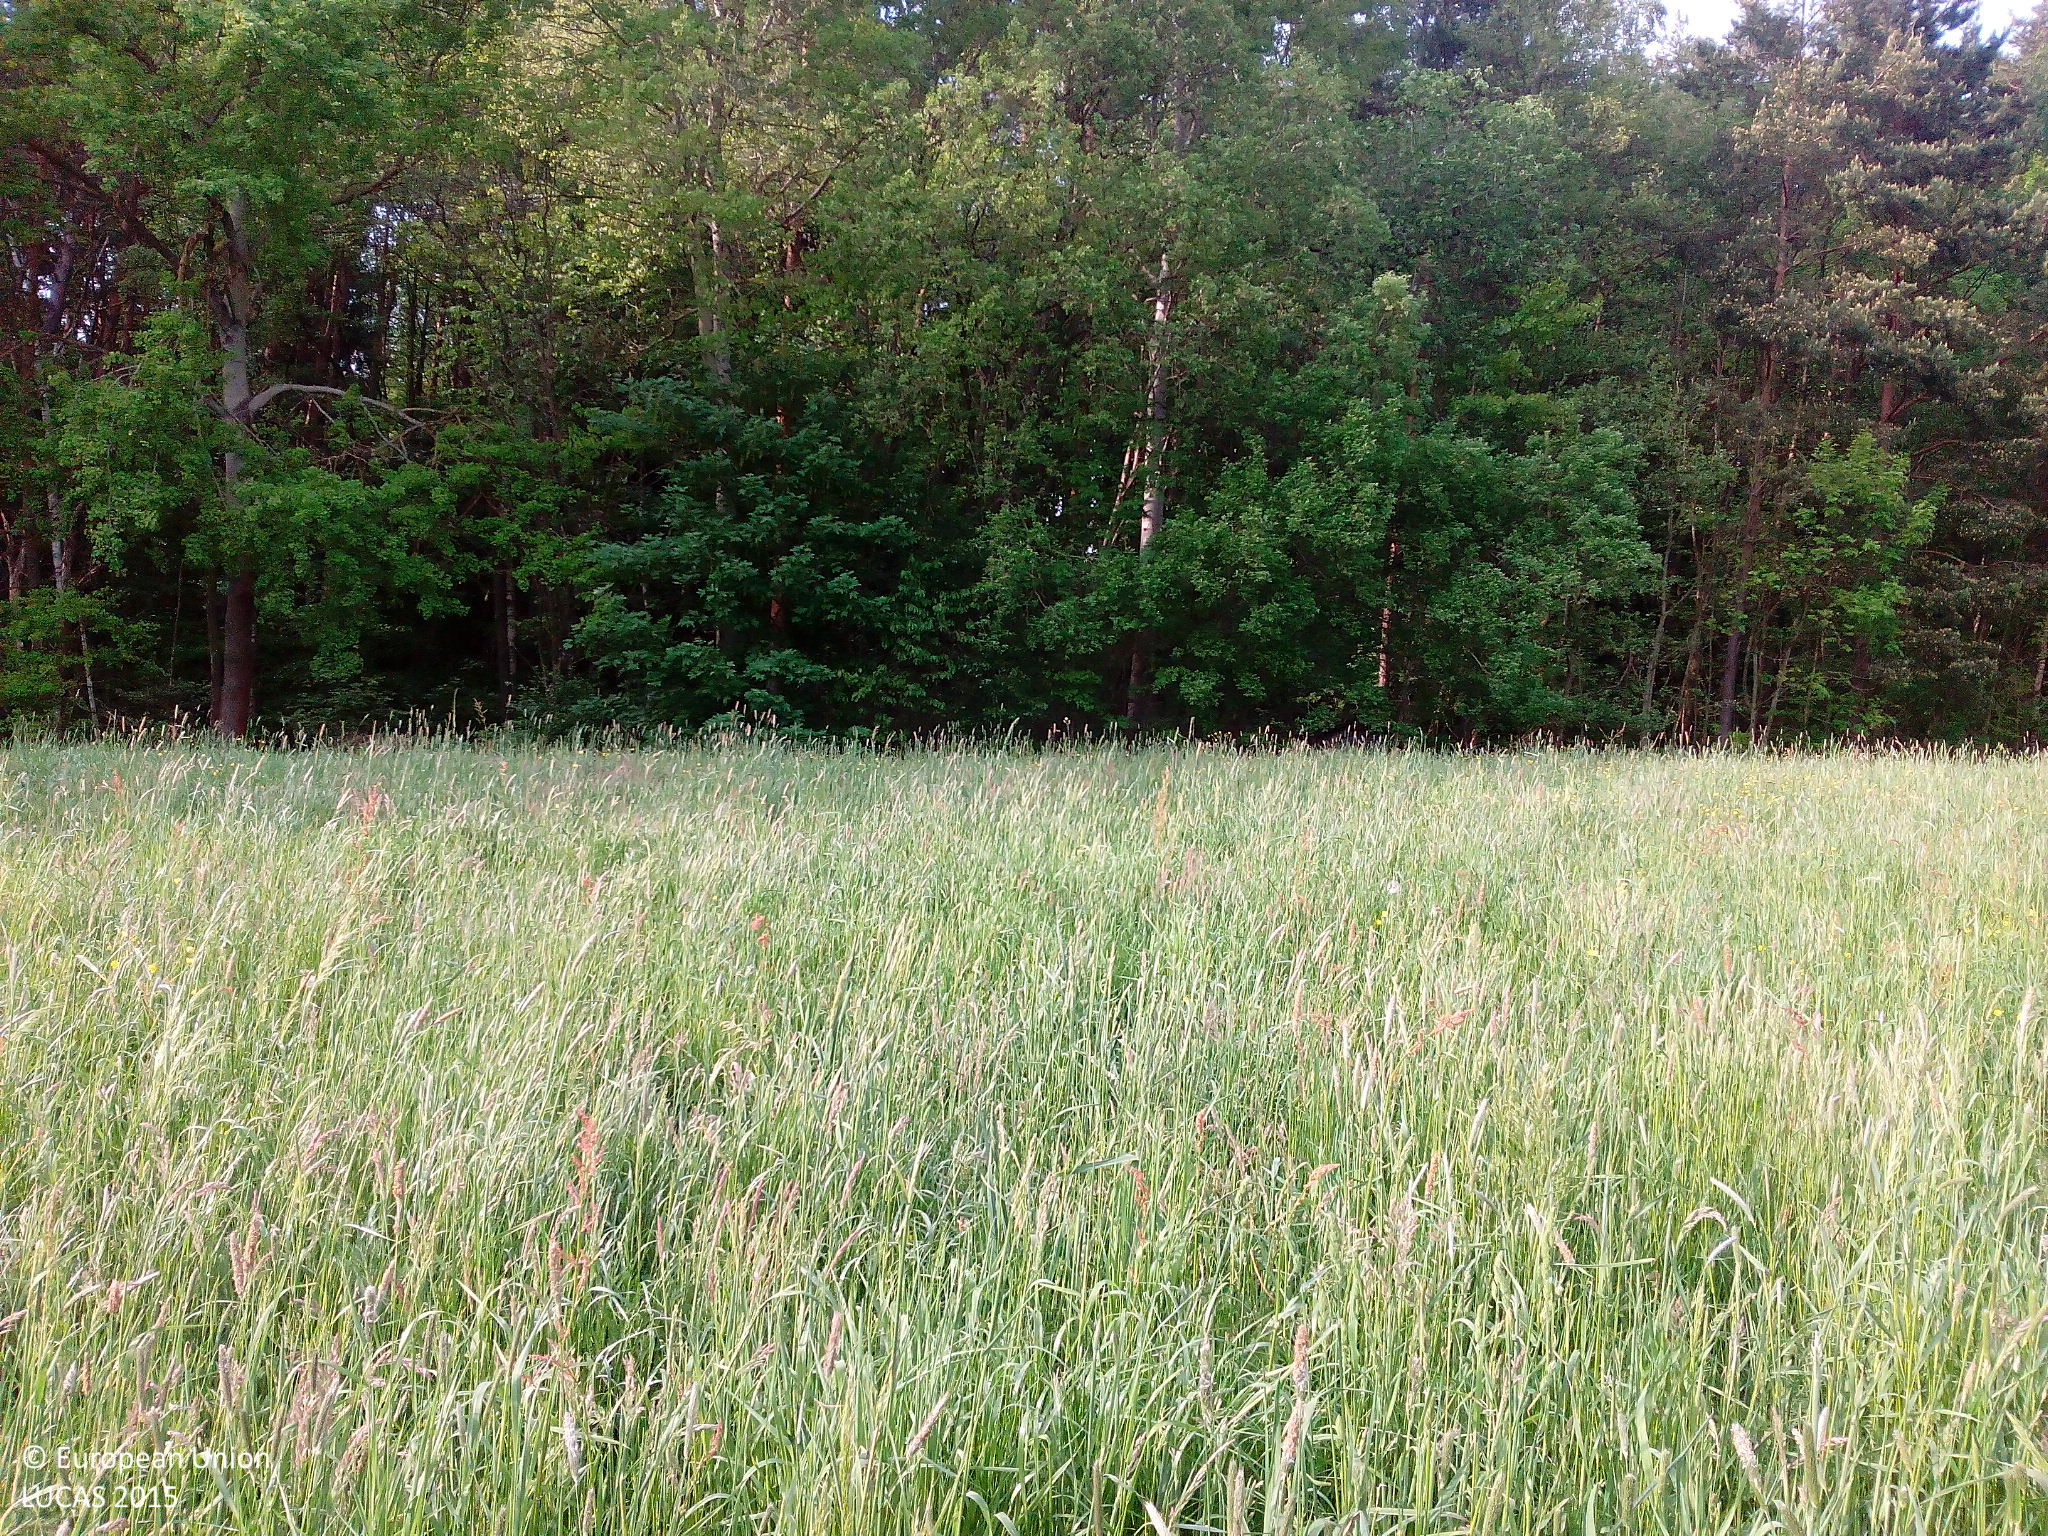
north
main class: Grassland
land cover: Grassland without tree/shrub cover
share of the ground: > 75 %
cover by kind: herbaceous plants 100 %
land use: Agriculture (excluding fallow land and kitchen gardens)
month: May
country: DE
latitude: 49.8332
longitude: 11.4594
